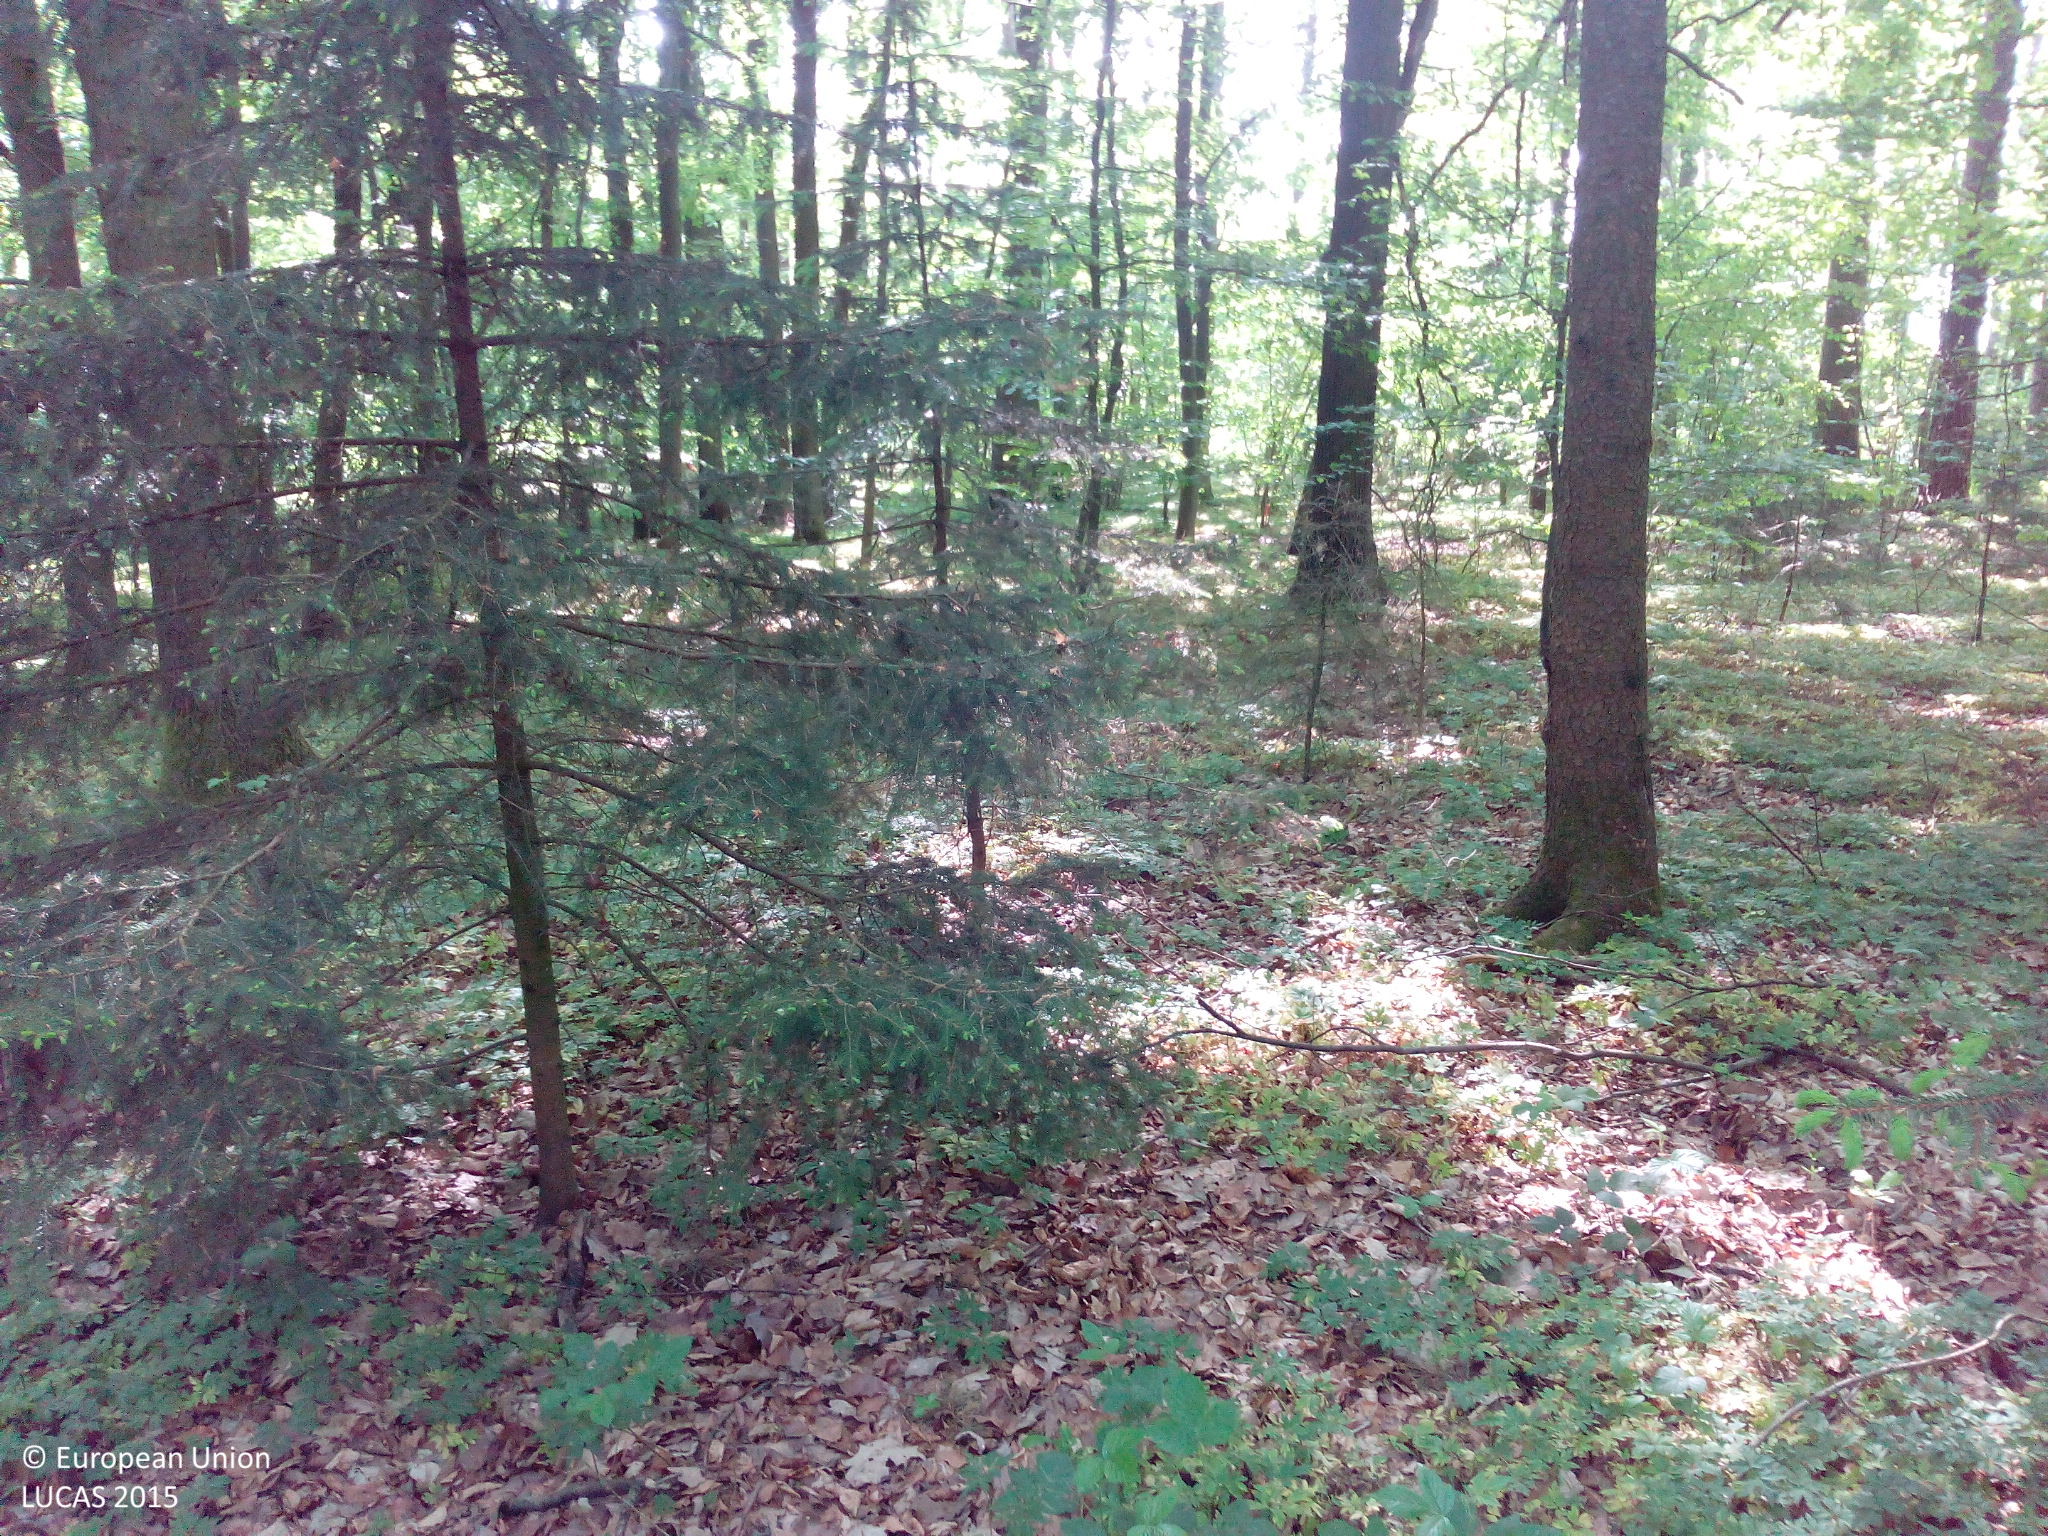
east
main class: Woodland
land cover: Broadleaved woodland
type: mesophytic deciduous forest
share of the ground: > 75 %
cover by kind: broadleaved forest trees 85 %, coniferous forest trees 10 %, herbaceous plants 5 %
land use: Forestry
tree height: > 5 m
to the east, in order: Broadleaved woodland; Tracks; Broadleaved woodland; Grassland without tree/shrub cover; Broadleaved woodland; Grass margins; Ditches and canals; Grass margins; Paved roads, cycling and walking lanes; Grass margins; Broadleaved woodland; Tracks; Barley
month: May
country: DE
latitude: 50.0907
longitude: 10.9083
